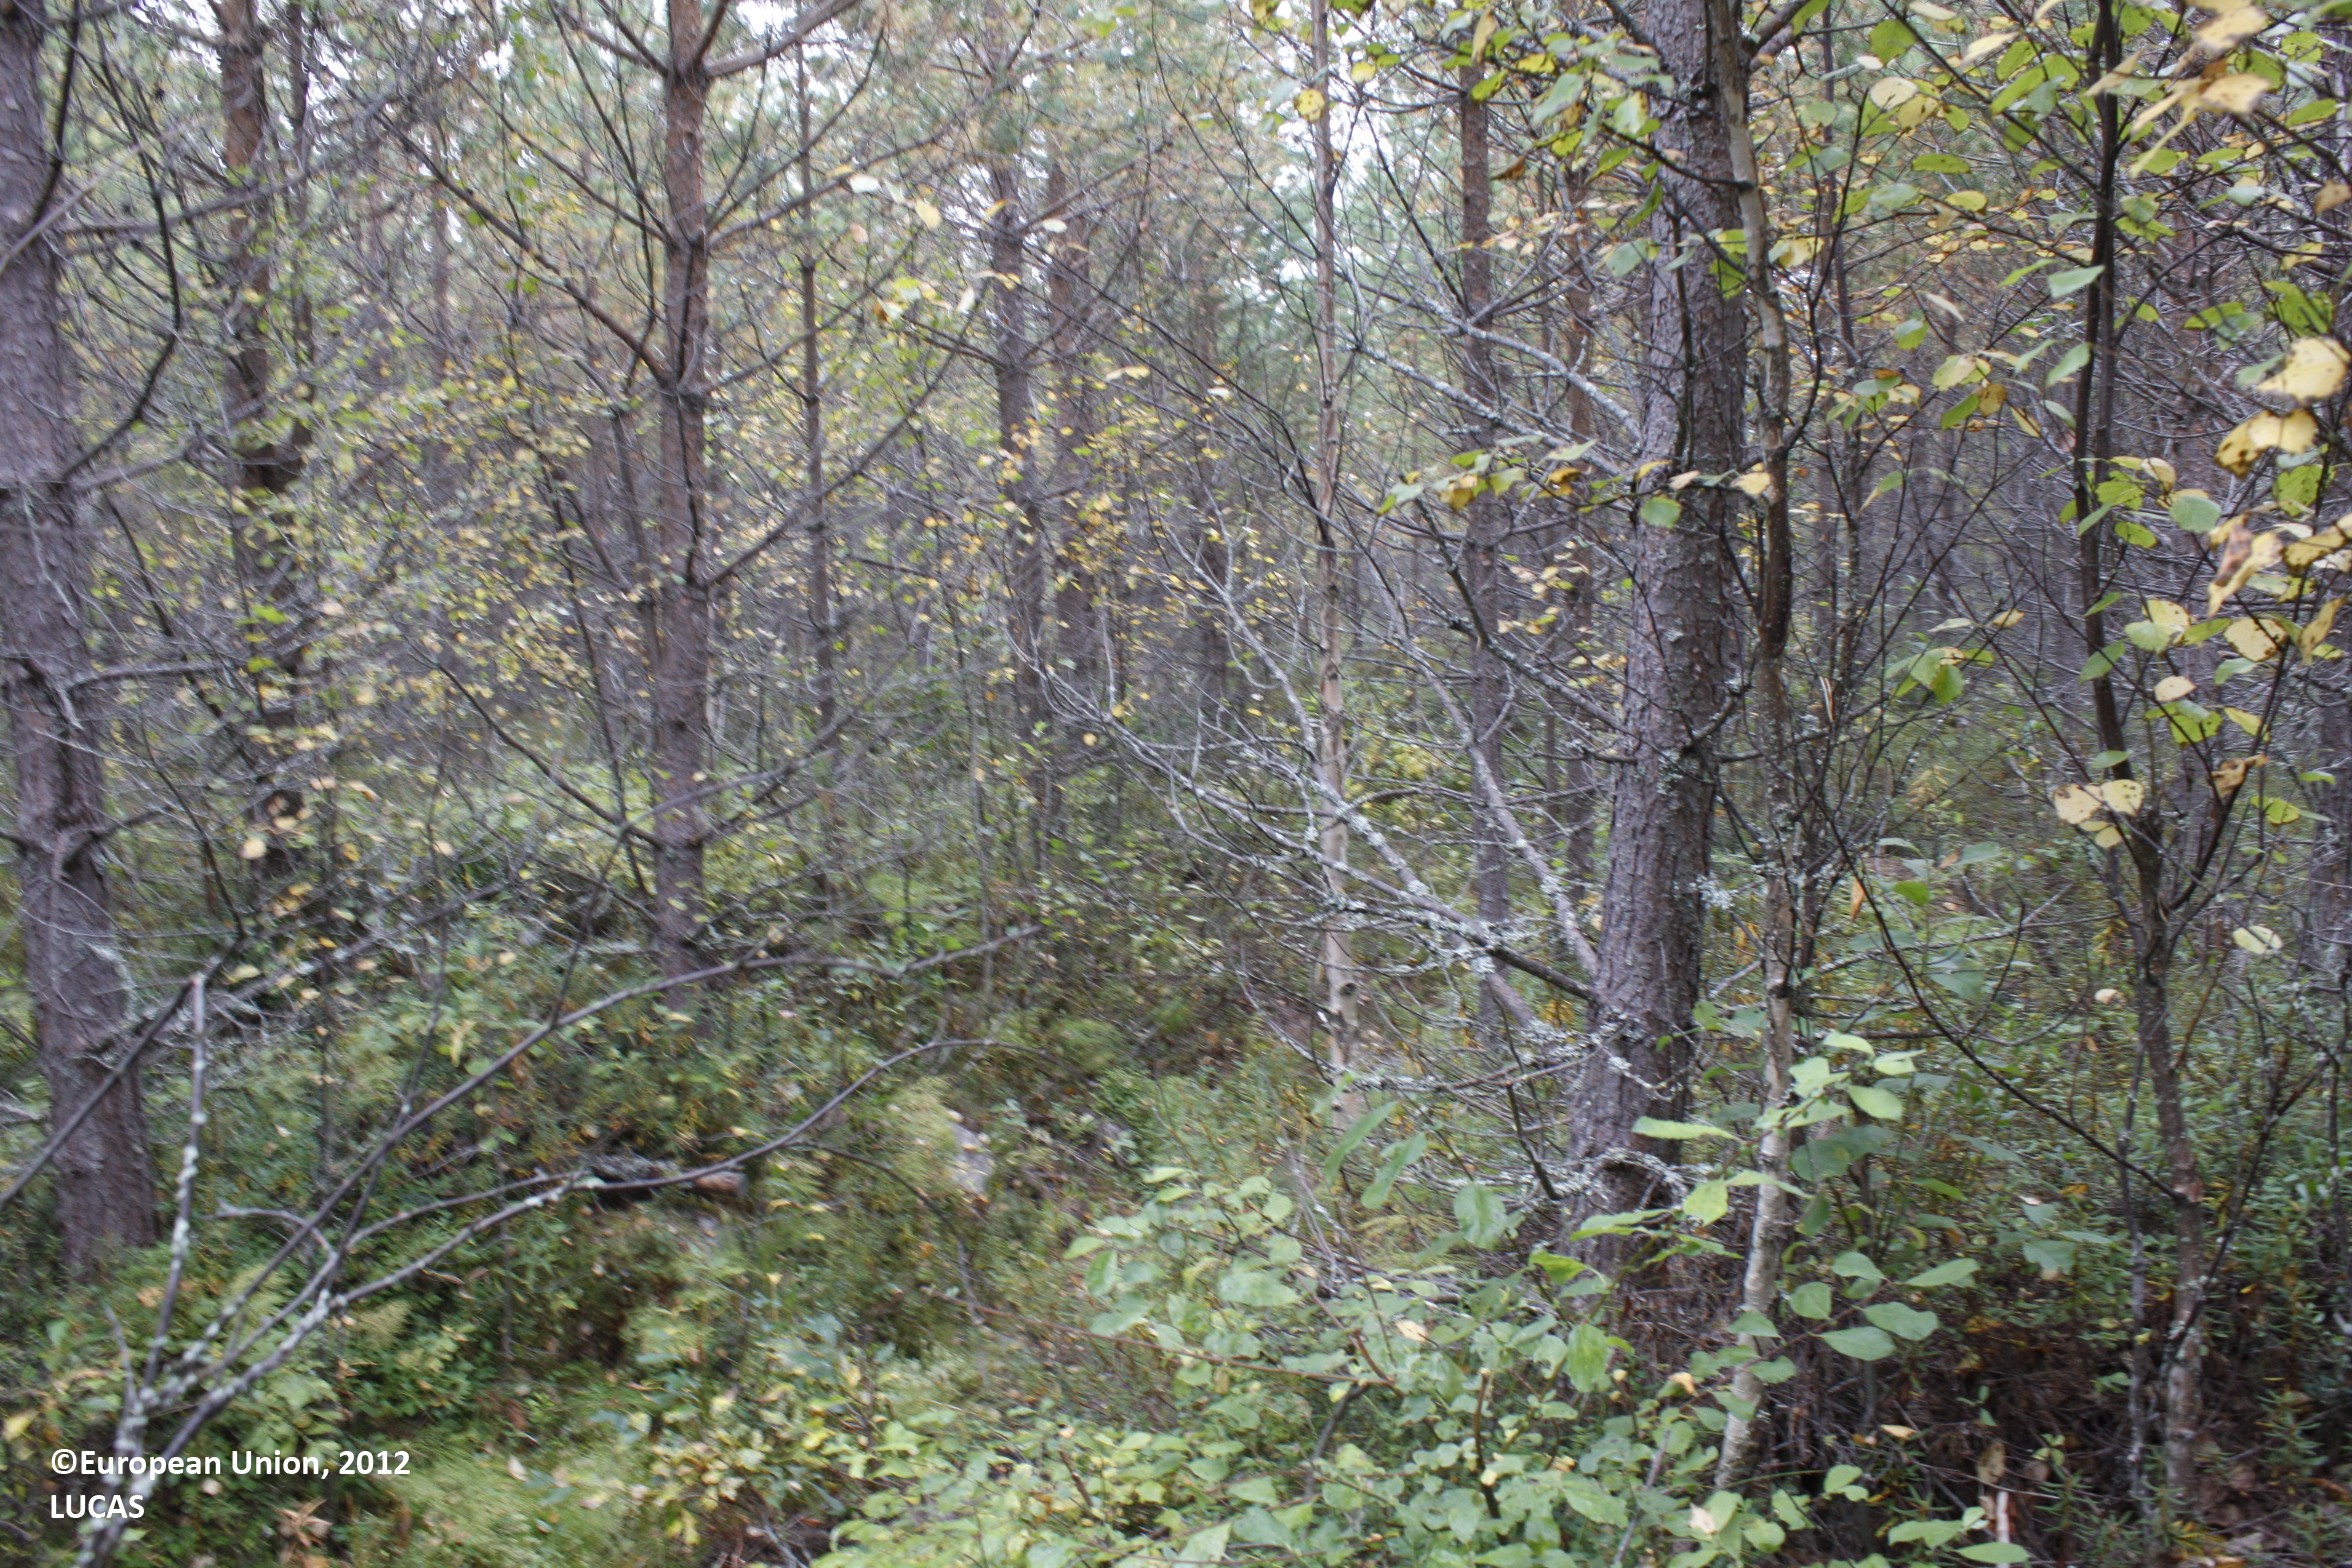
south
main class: Woodland
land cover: Pine dominated mixed woodland
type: mire and swamp forests
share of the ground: > 75 %
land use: Forestry
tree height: > 5 m
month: September
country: FI
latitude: 65.3666
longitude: 26.8184
